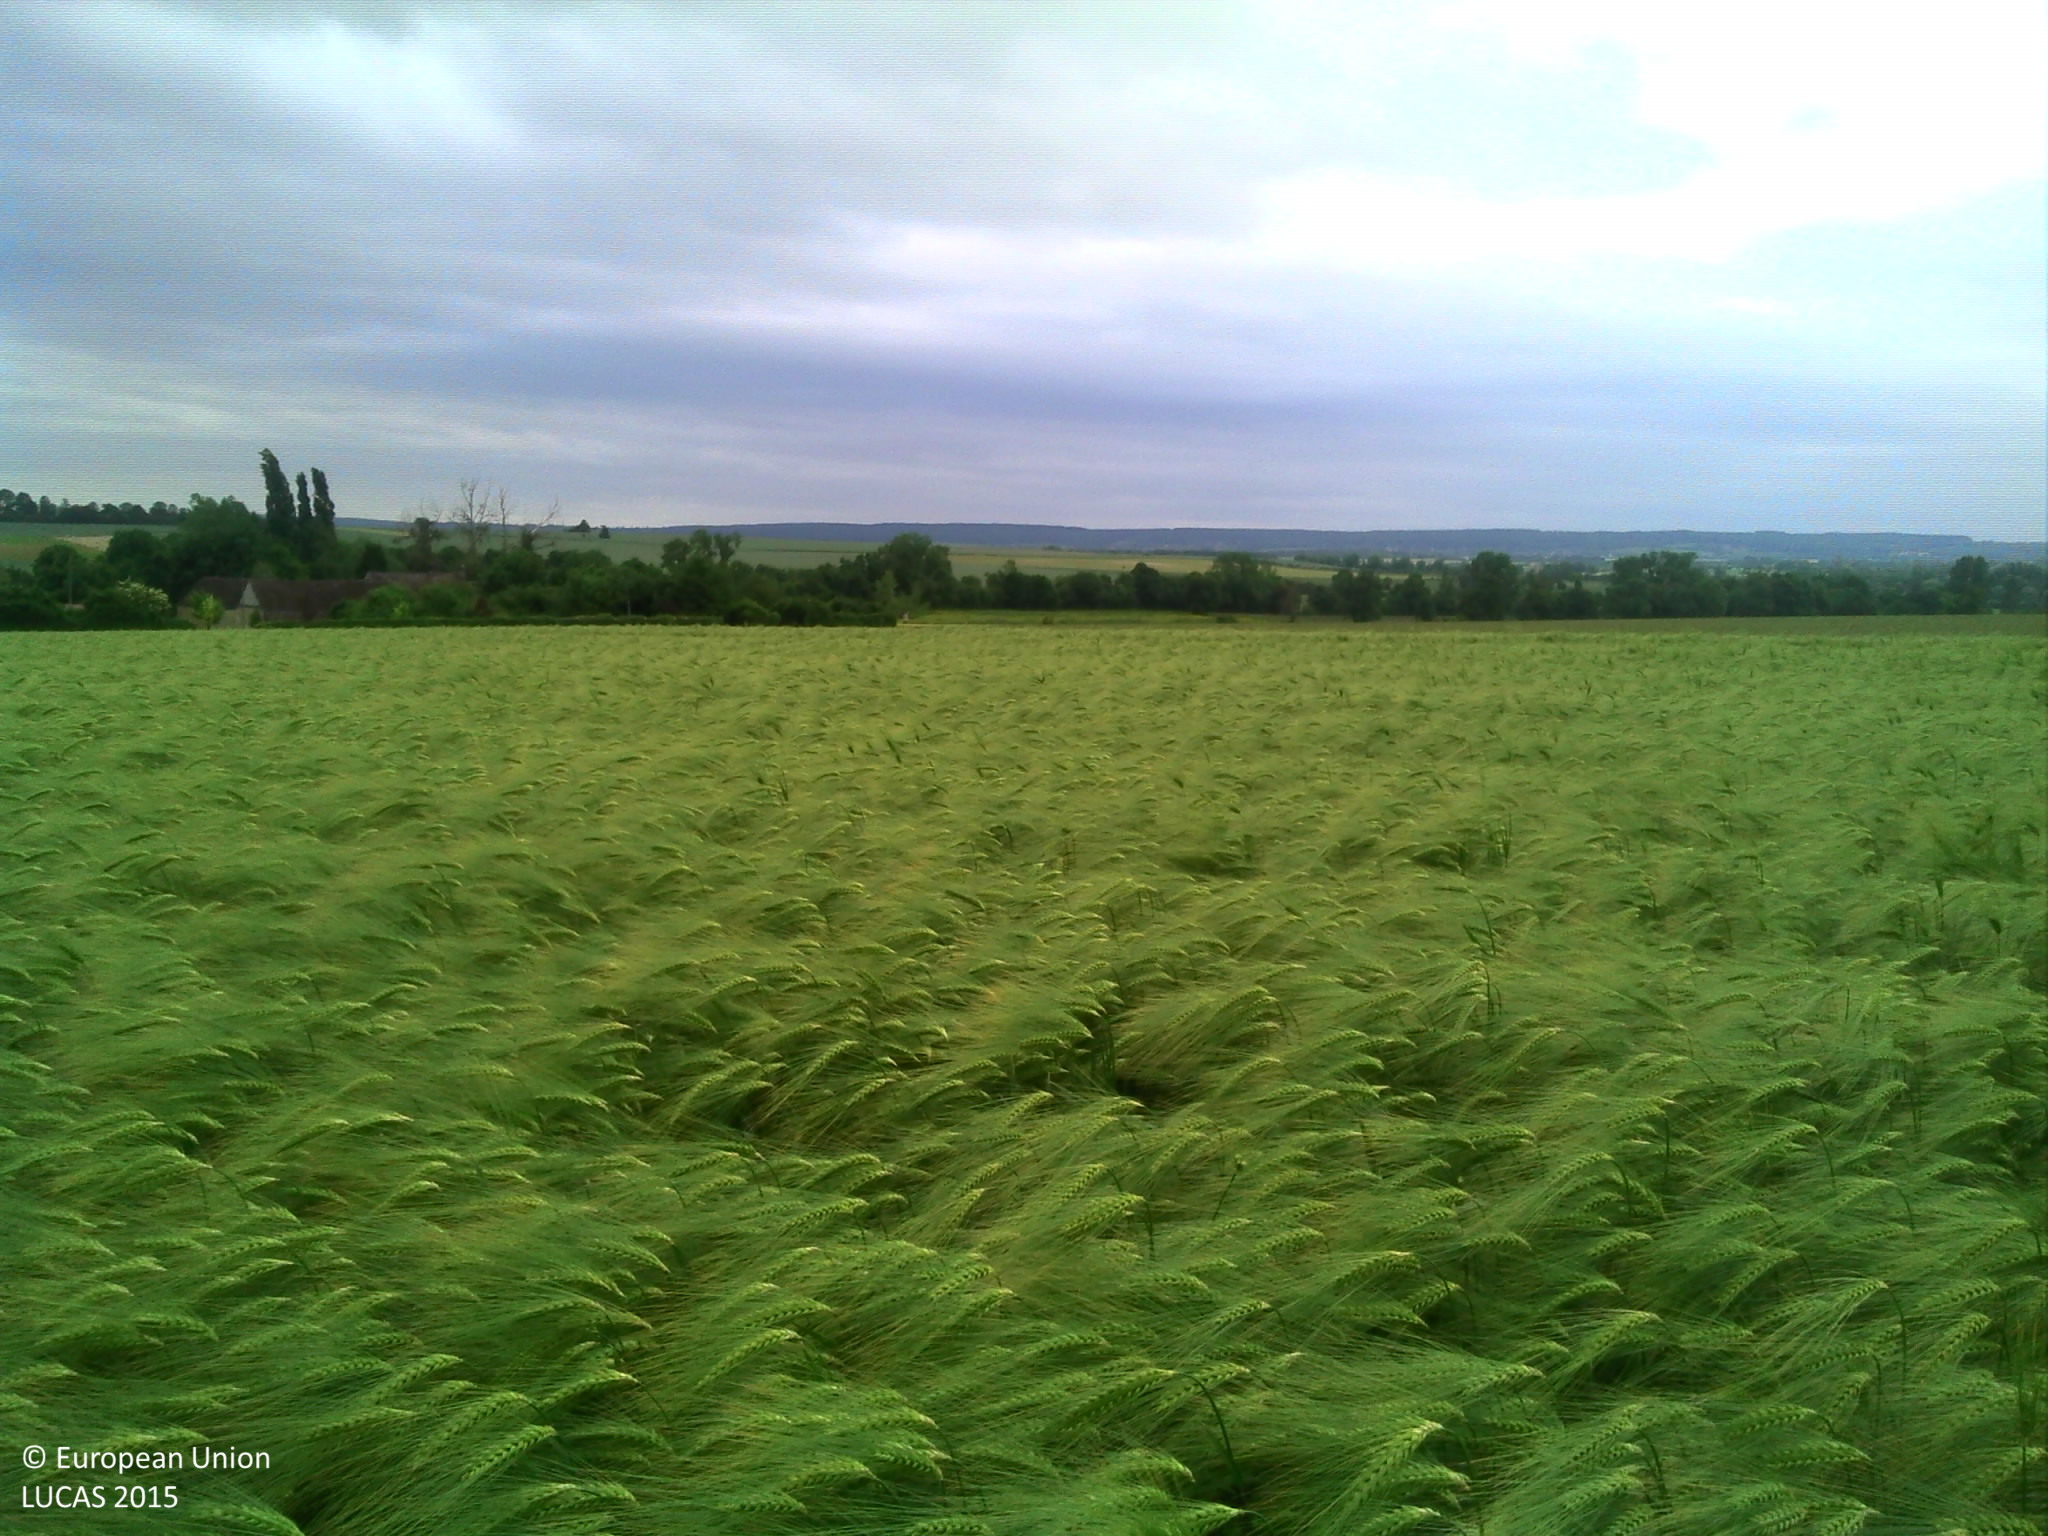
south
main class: Cropland
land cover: Barley
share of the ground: > 75 %
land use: Agriculture (excluding fallow land and kitchen gardens)
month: June
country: FR
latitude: 48.8431
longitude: 0.0641
